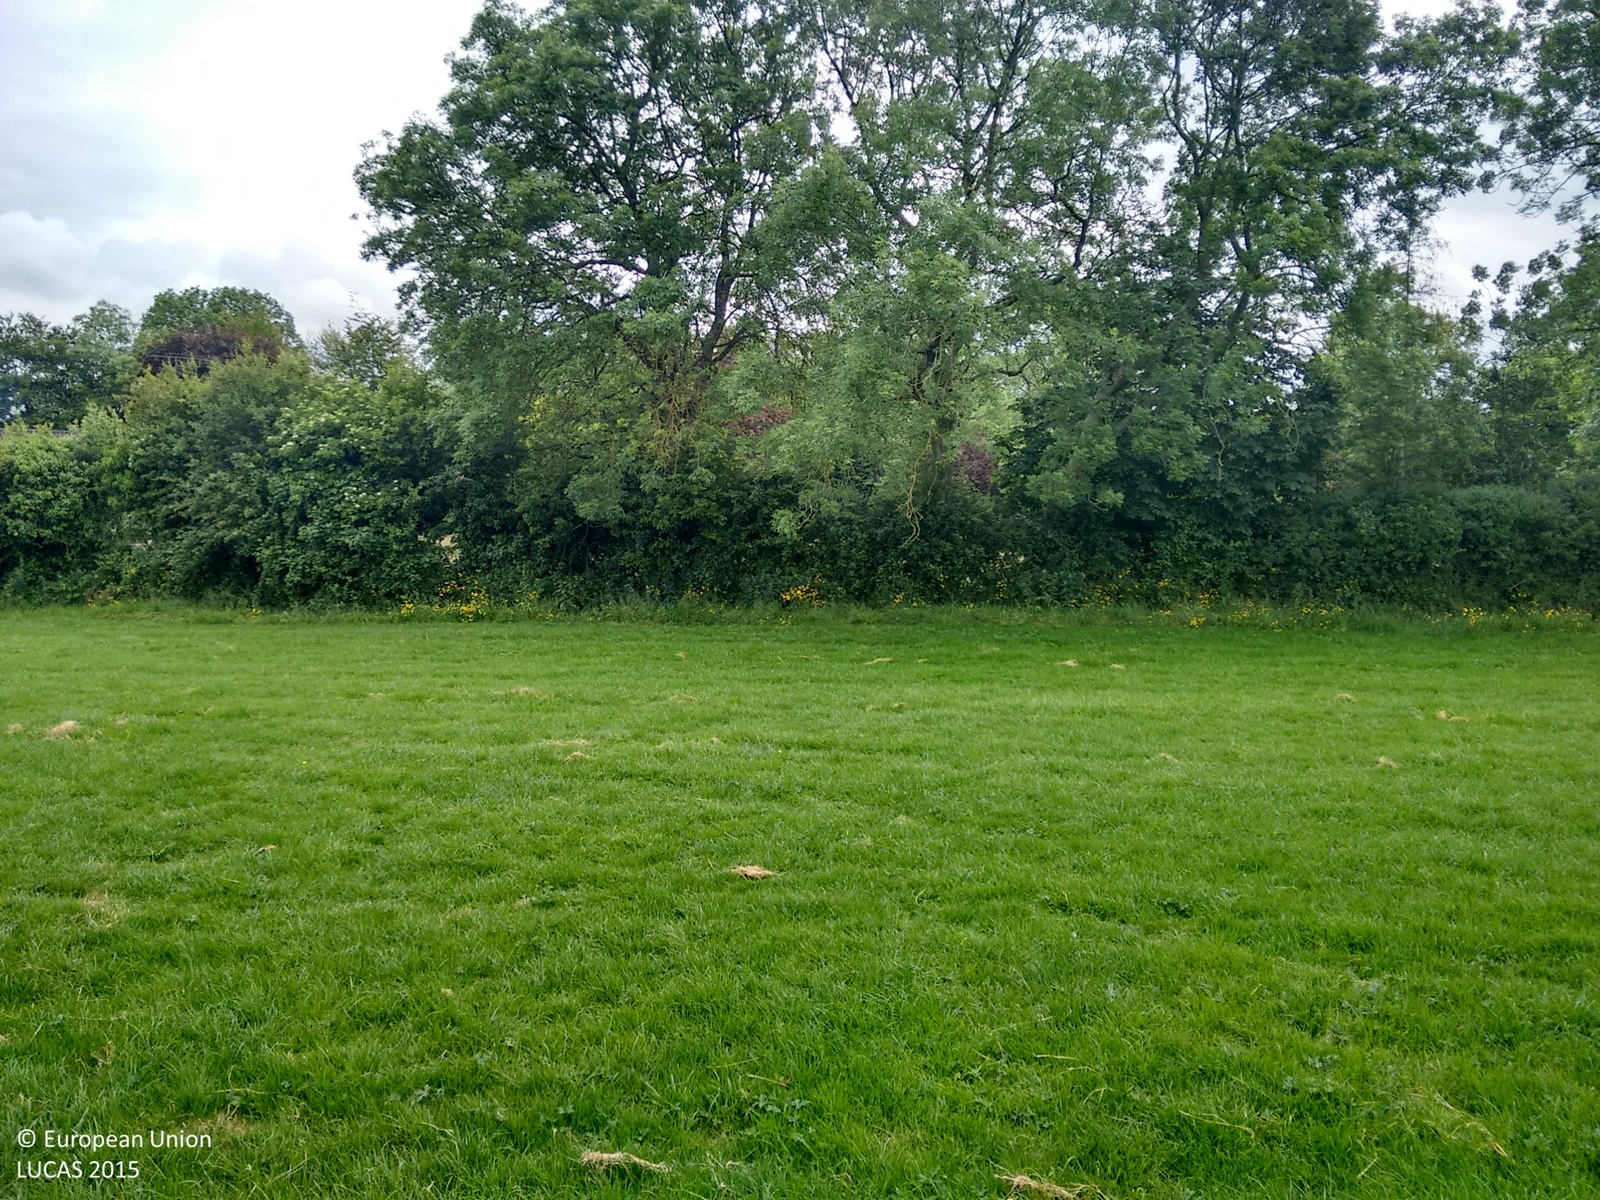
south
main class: Grassland
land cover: Grassland without tree/shrub cover
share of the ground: > 75 %
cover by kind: herbaceous plants 100 %
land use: Agriculture (excluding fallow land and kitchen gardens)
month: June
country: IE
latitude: 53.6424
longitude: -6.7266
